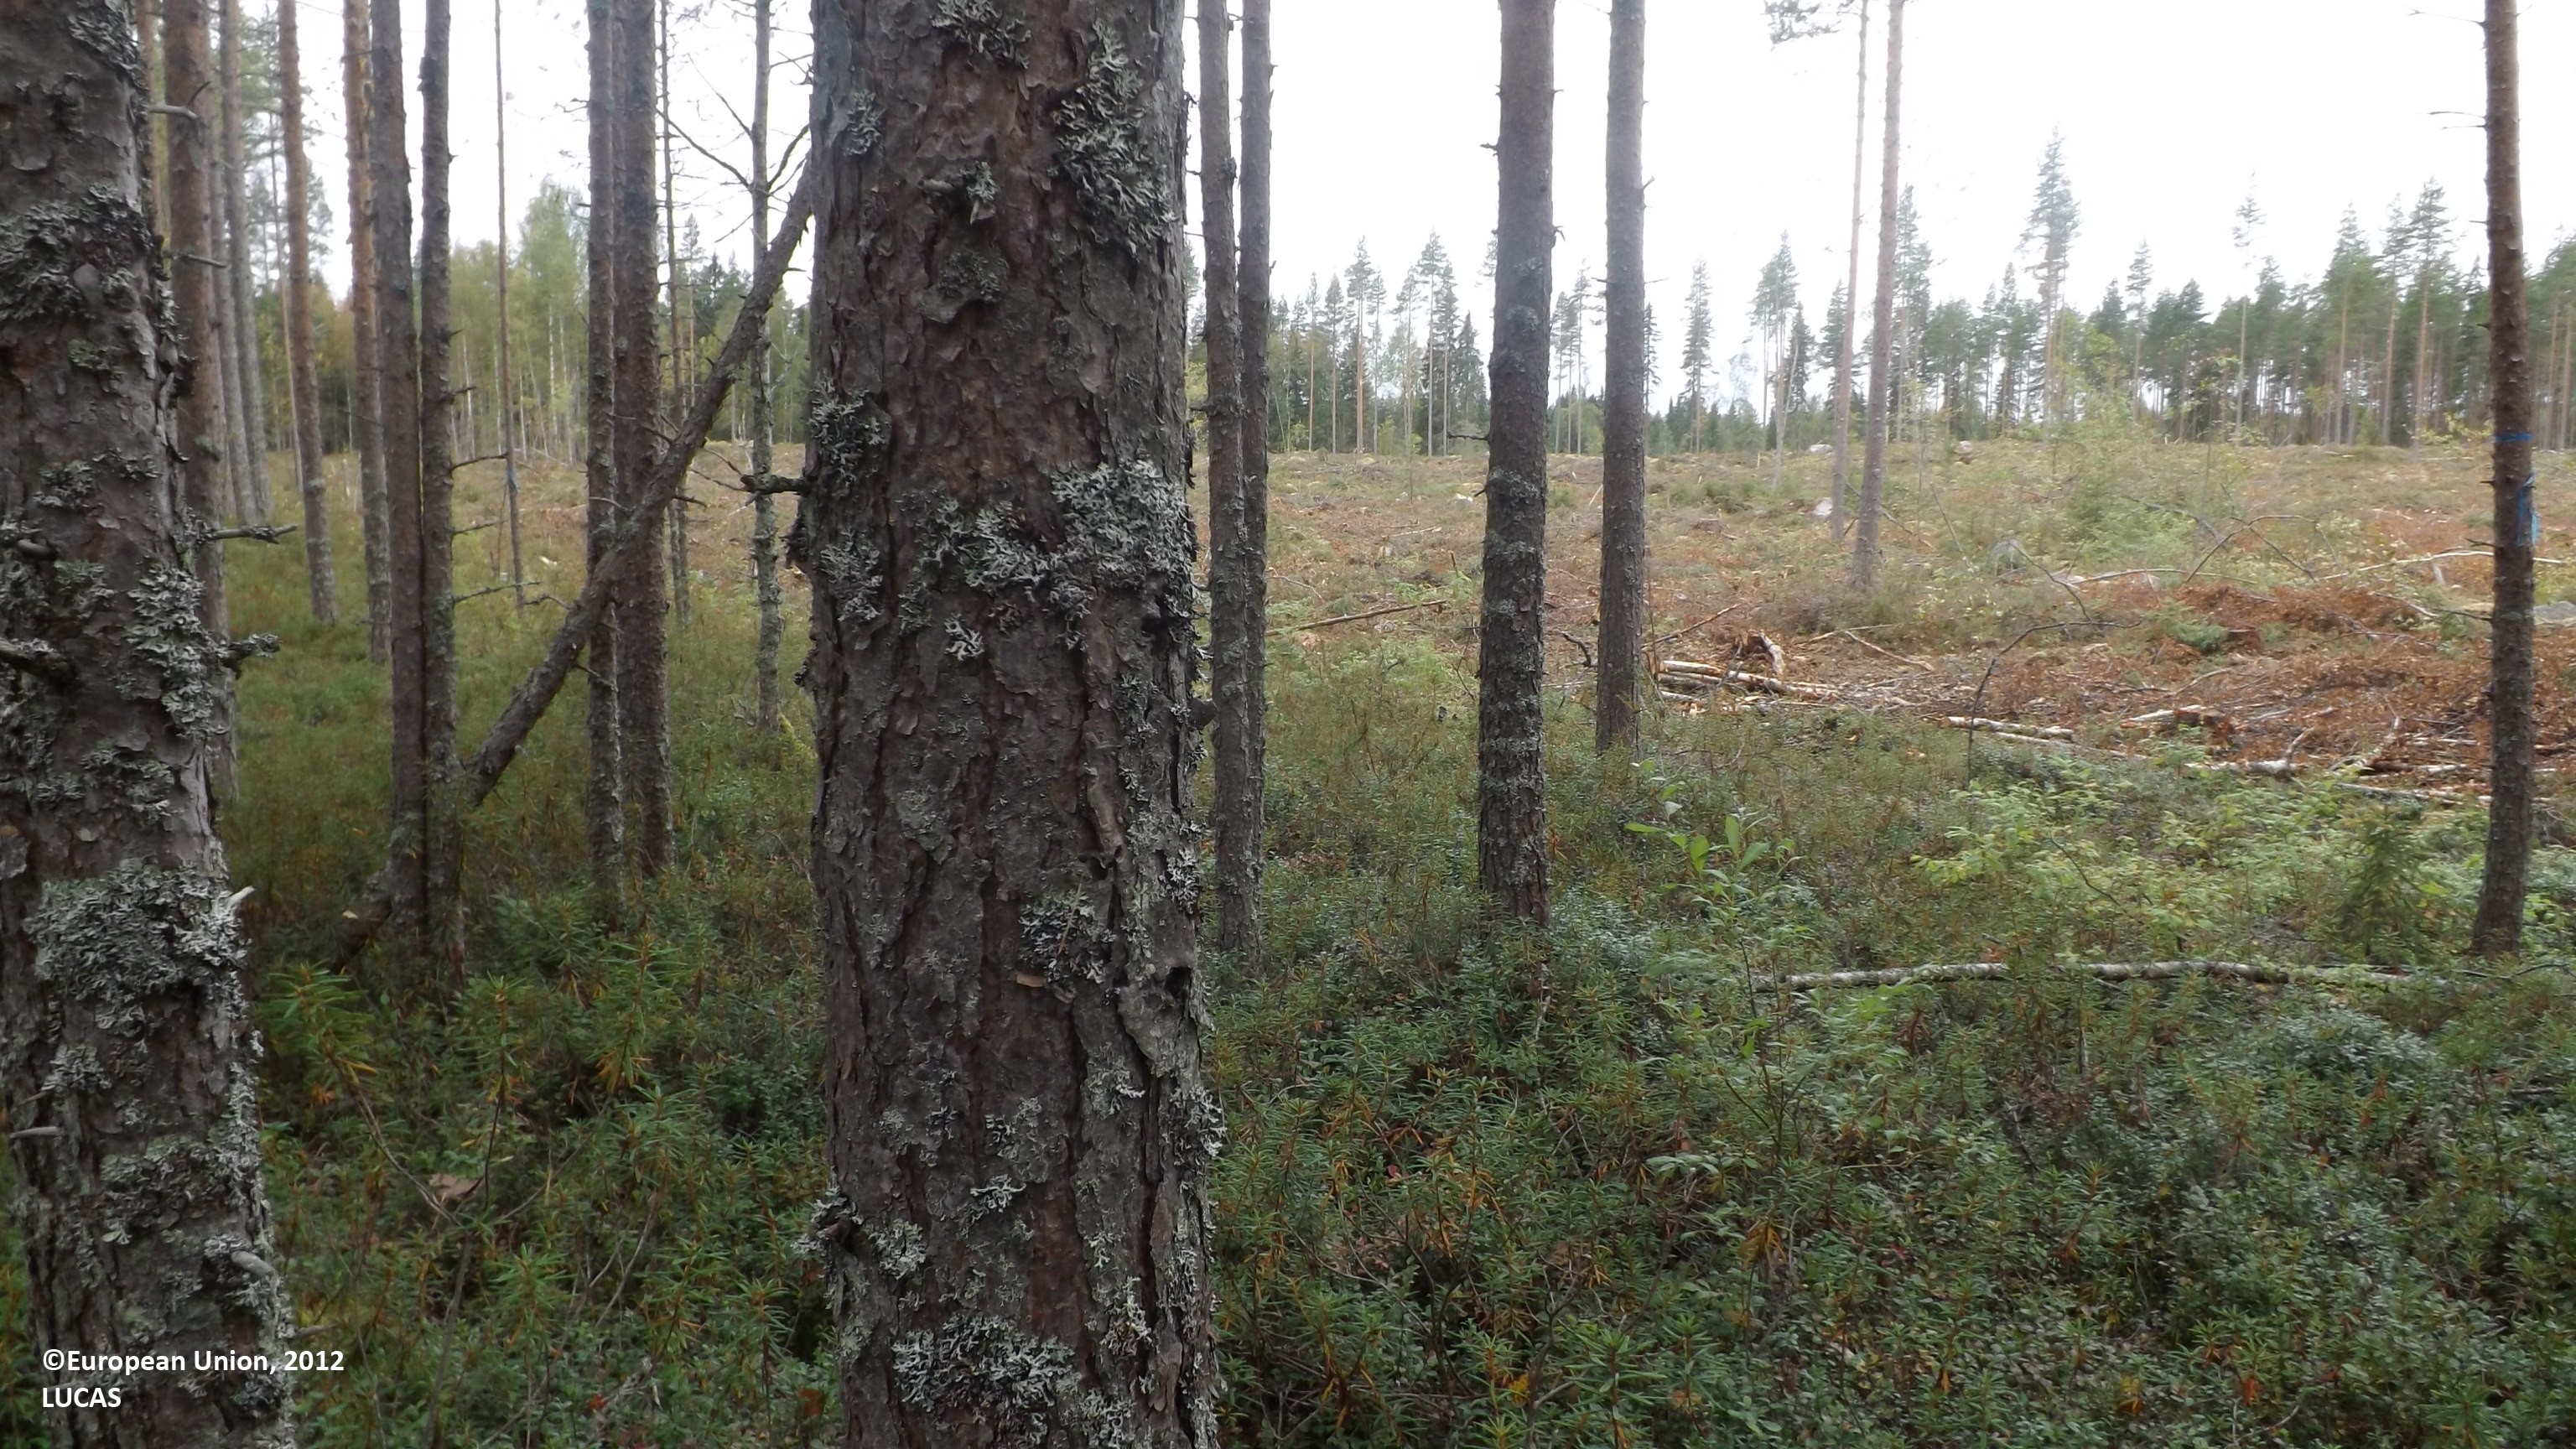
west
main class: Woodland
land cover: Pine dominated mixed woodland
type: boreal forest
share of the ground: 50 - 75 %
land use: Forestry
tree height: > 5 m
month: August
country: FI
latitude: 63.7981
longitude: 23.5179
